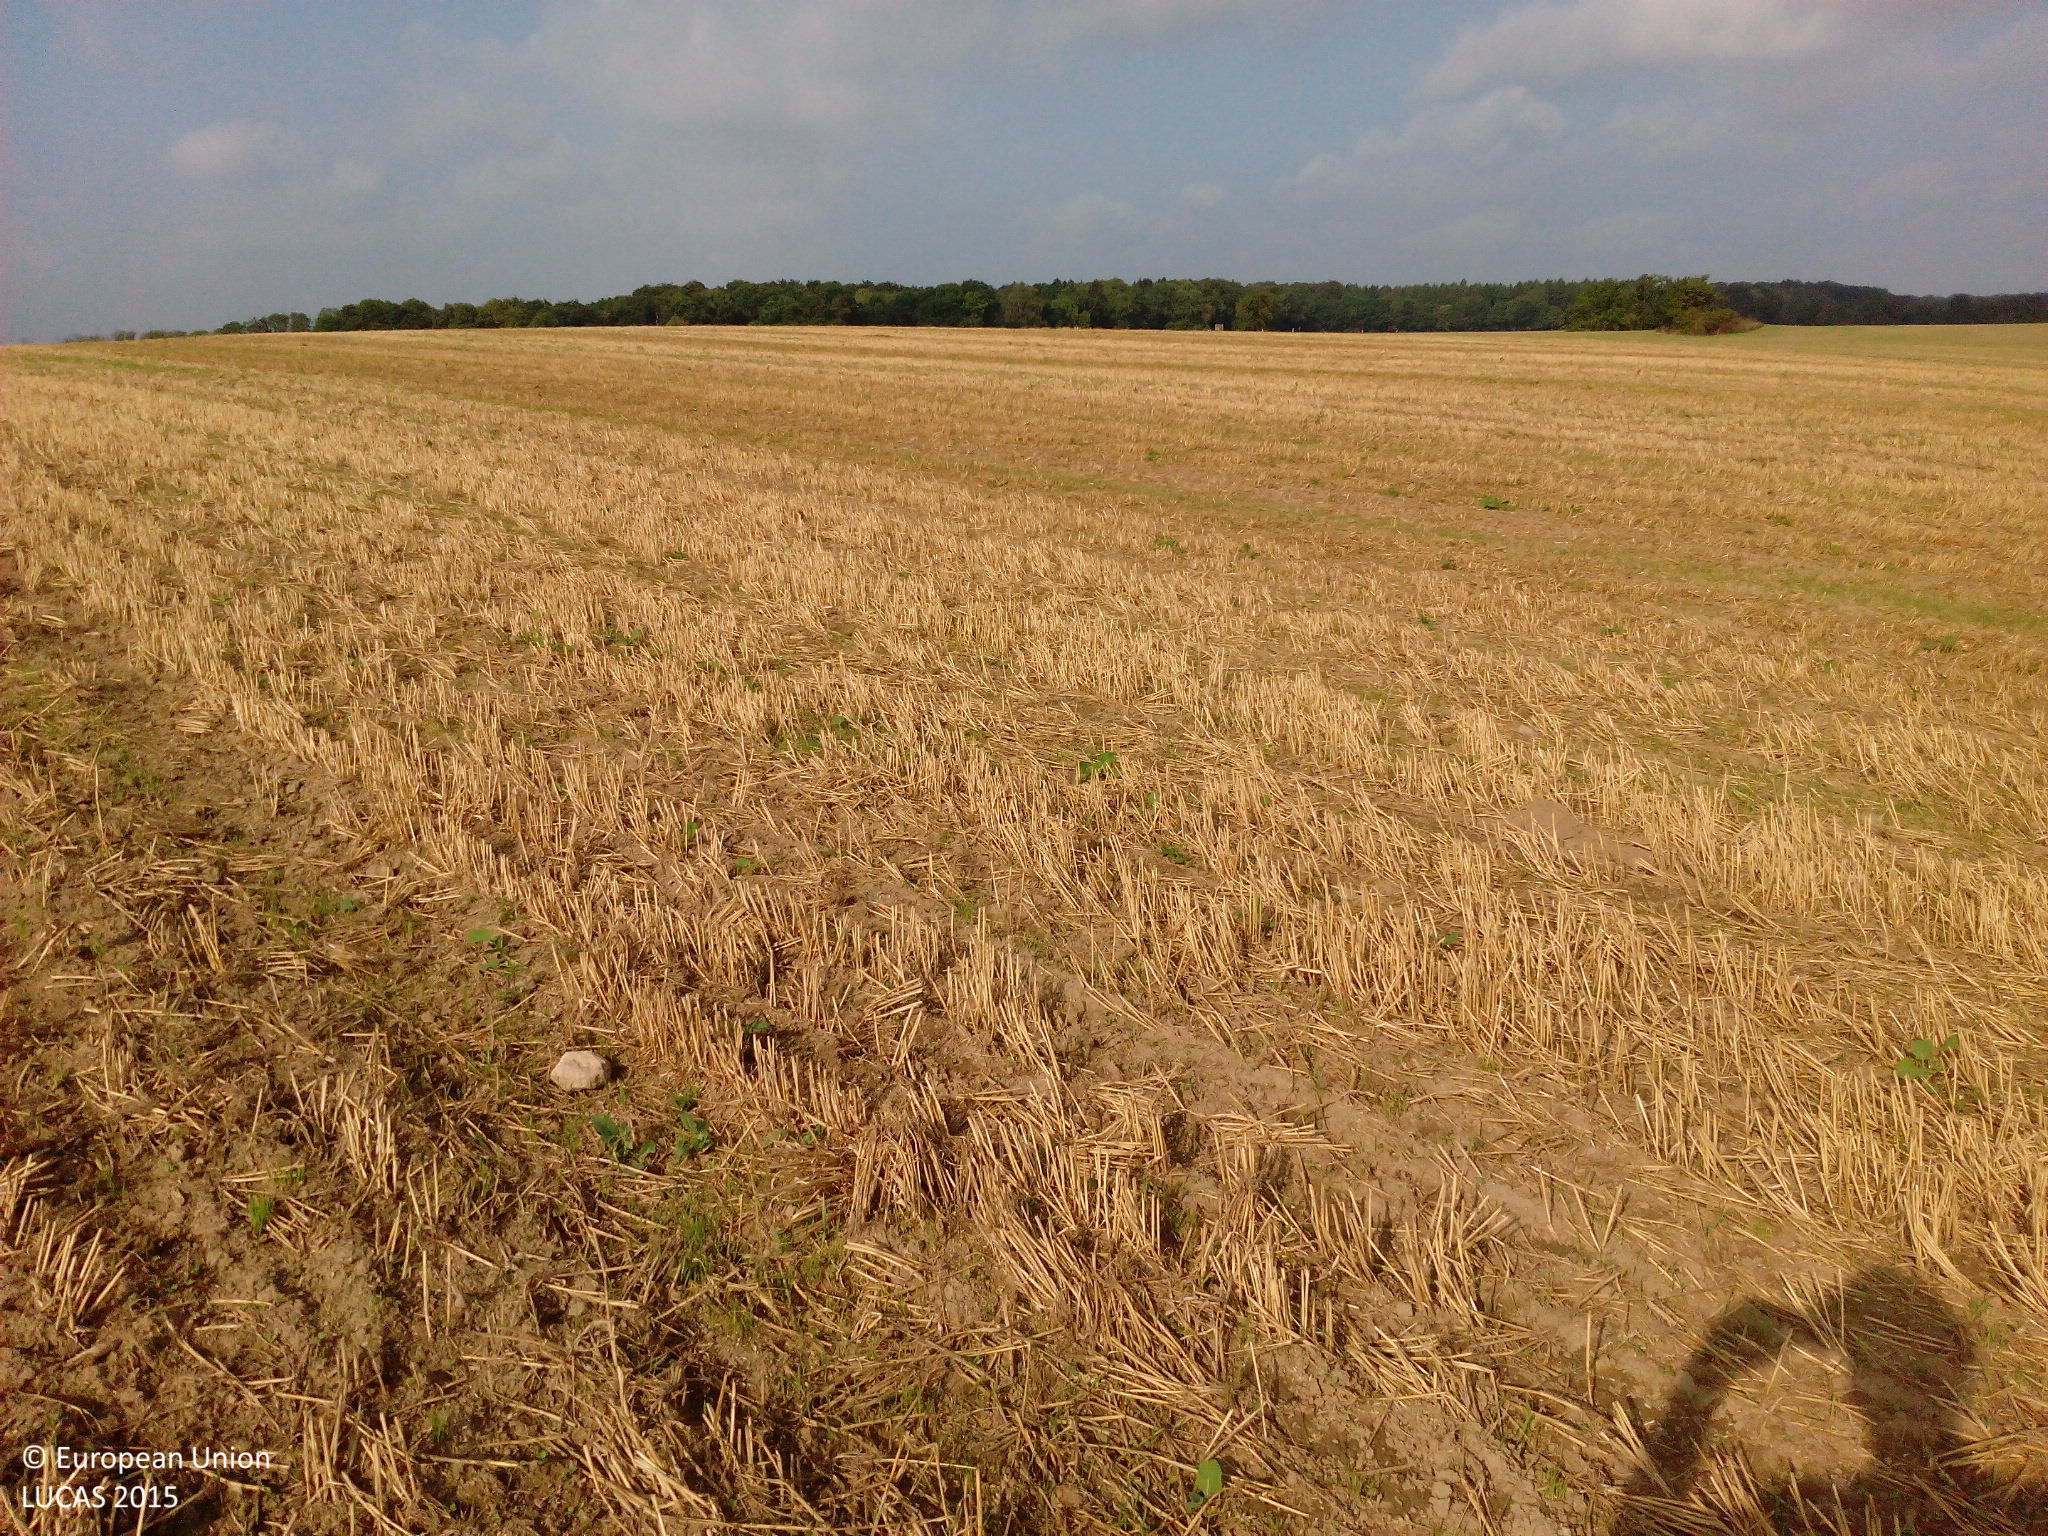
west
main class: Cropland
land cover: Common wheat
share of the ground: 50 - 75 %
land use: Agriculture (excluding fallow land and kitchen gardens)
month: September
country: DE
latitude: 54.1270
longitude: 12.7076
